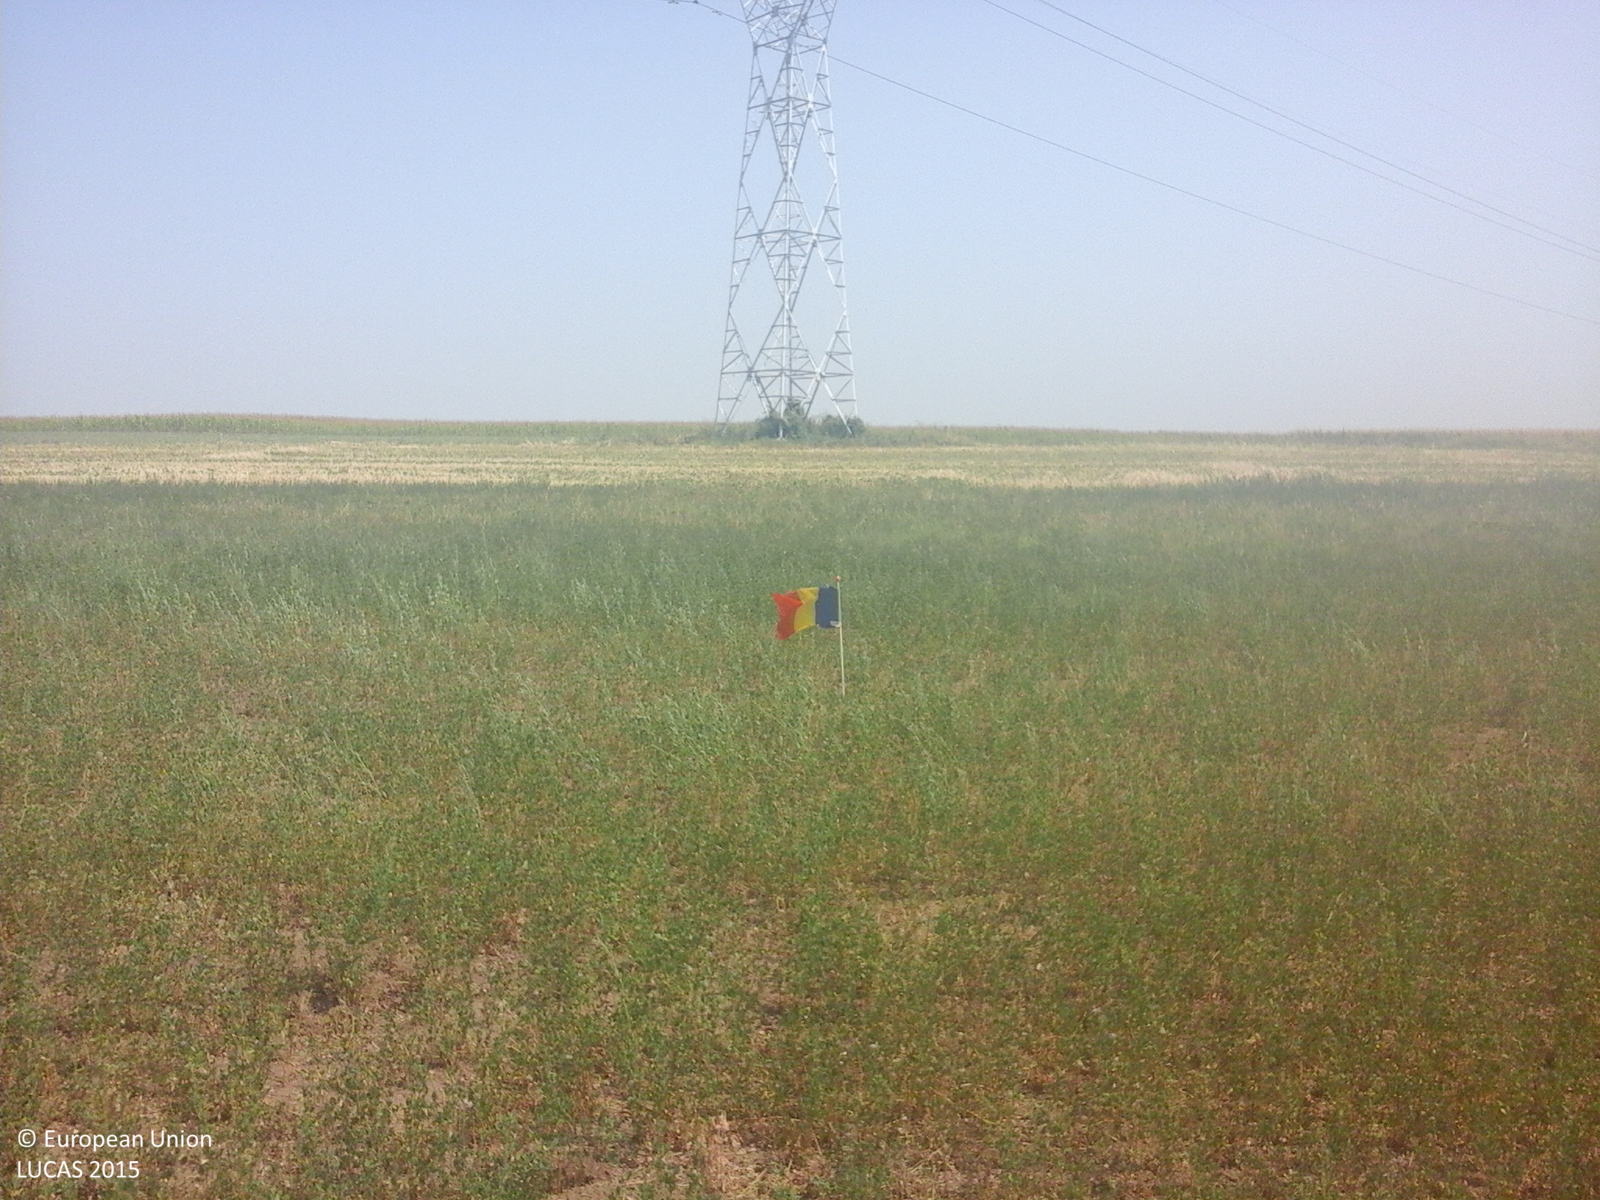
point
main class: Cropland
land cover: Lucerne
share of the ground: > 75 %
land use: Agriculture (excluding fallow land and kitchen gardens)
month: July
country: RO
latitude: 45.4953
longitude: 27.8622
